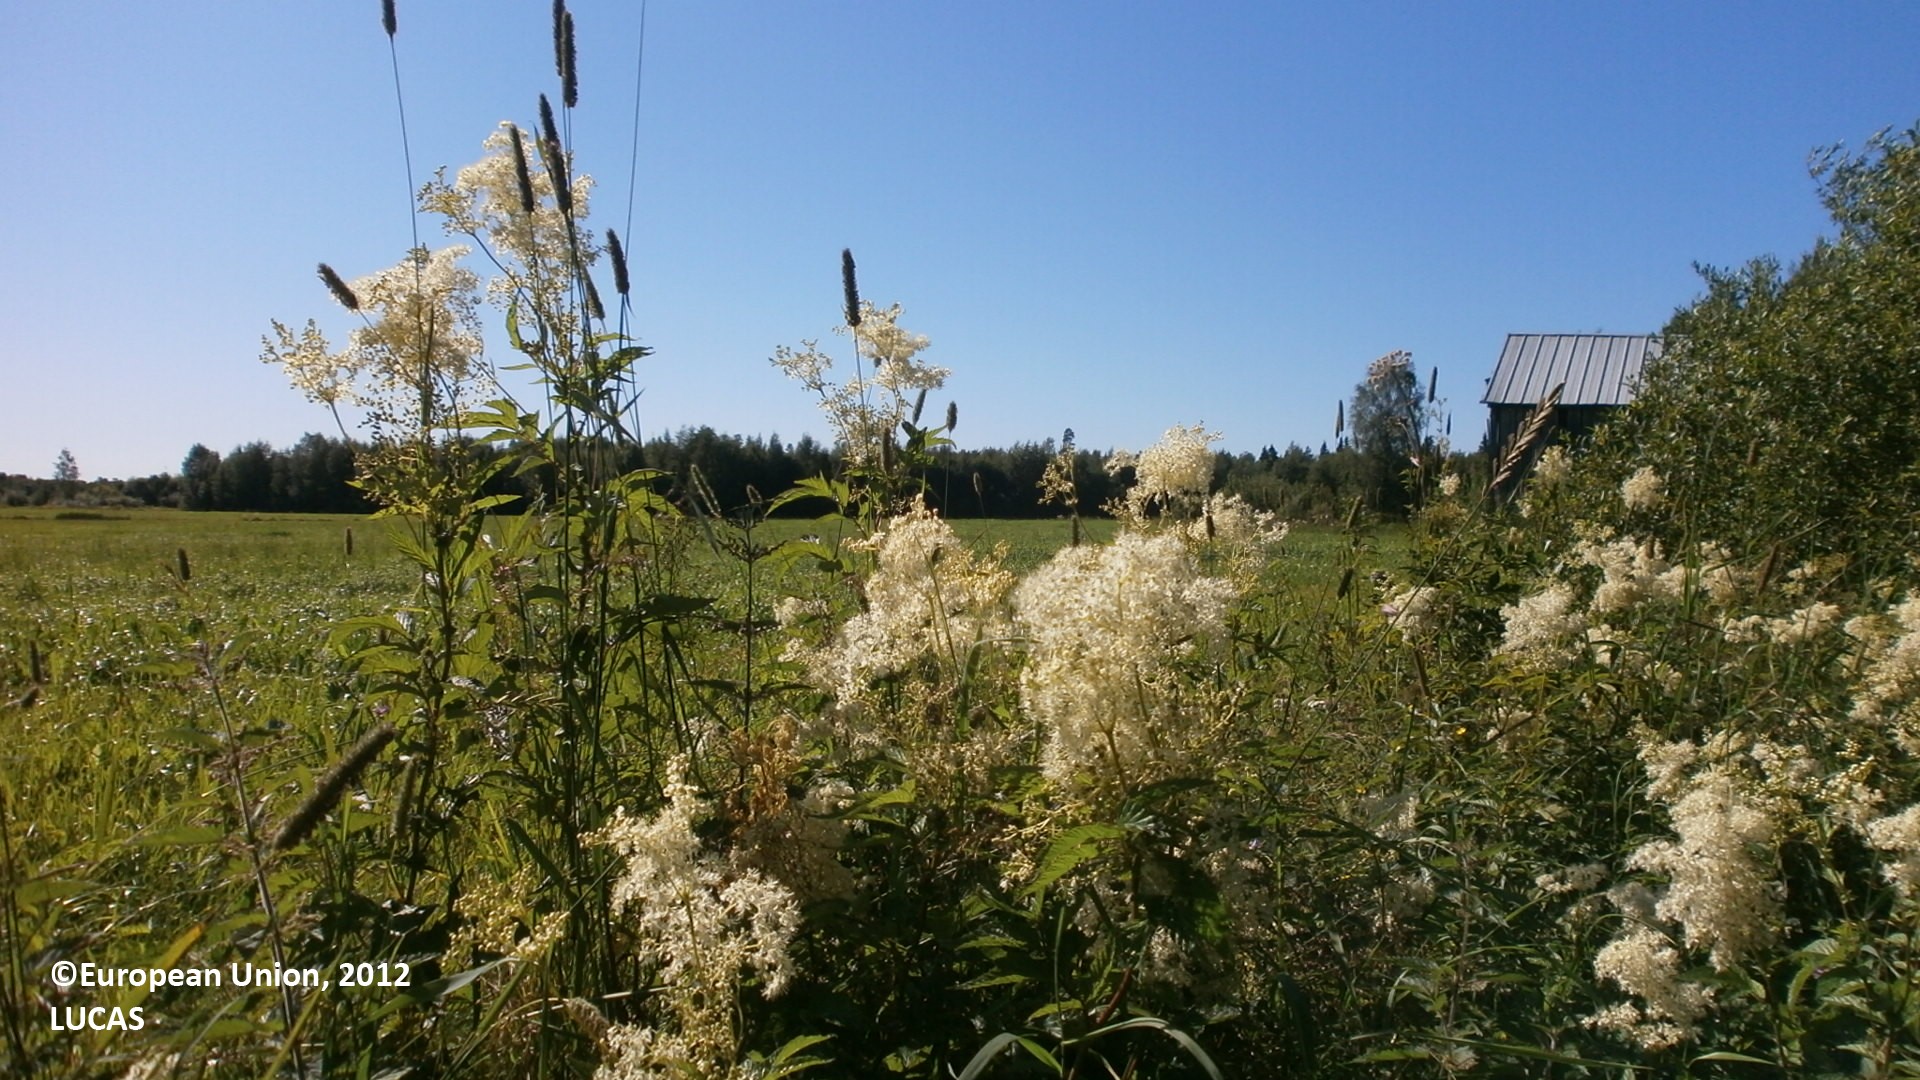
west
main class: Shrubland
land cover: Shrubland without tree cover
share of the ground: > 75 %
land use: Agriculture (excluding fallow land and kitchen gardens)
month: July
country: FI
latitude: 64.1437
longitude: 23.9768
